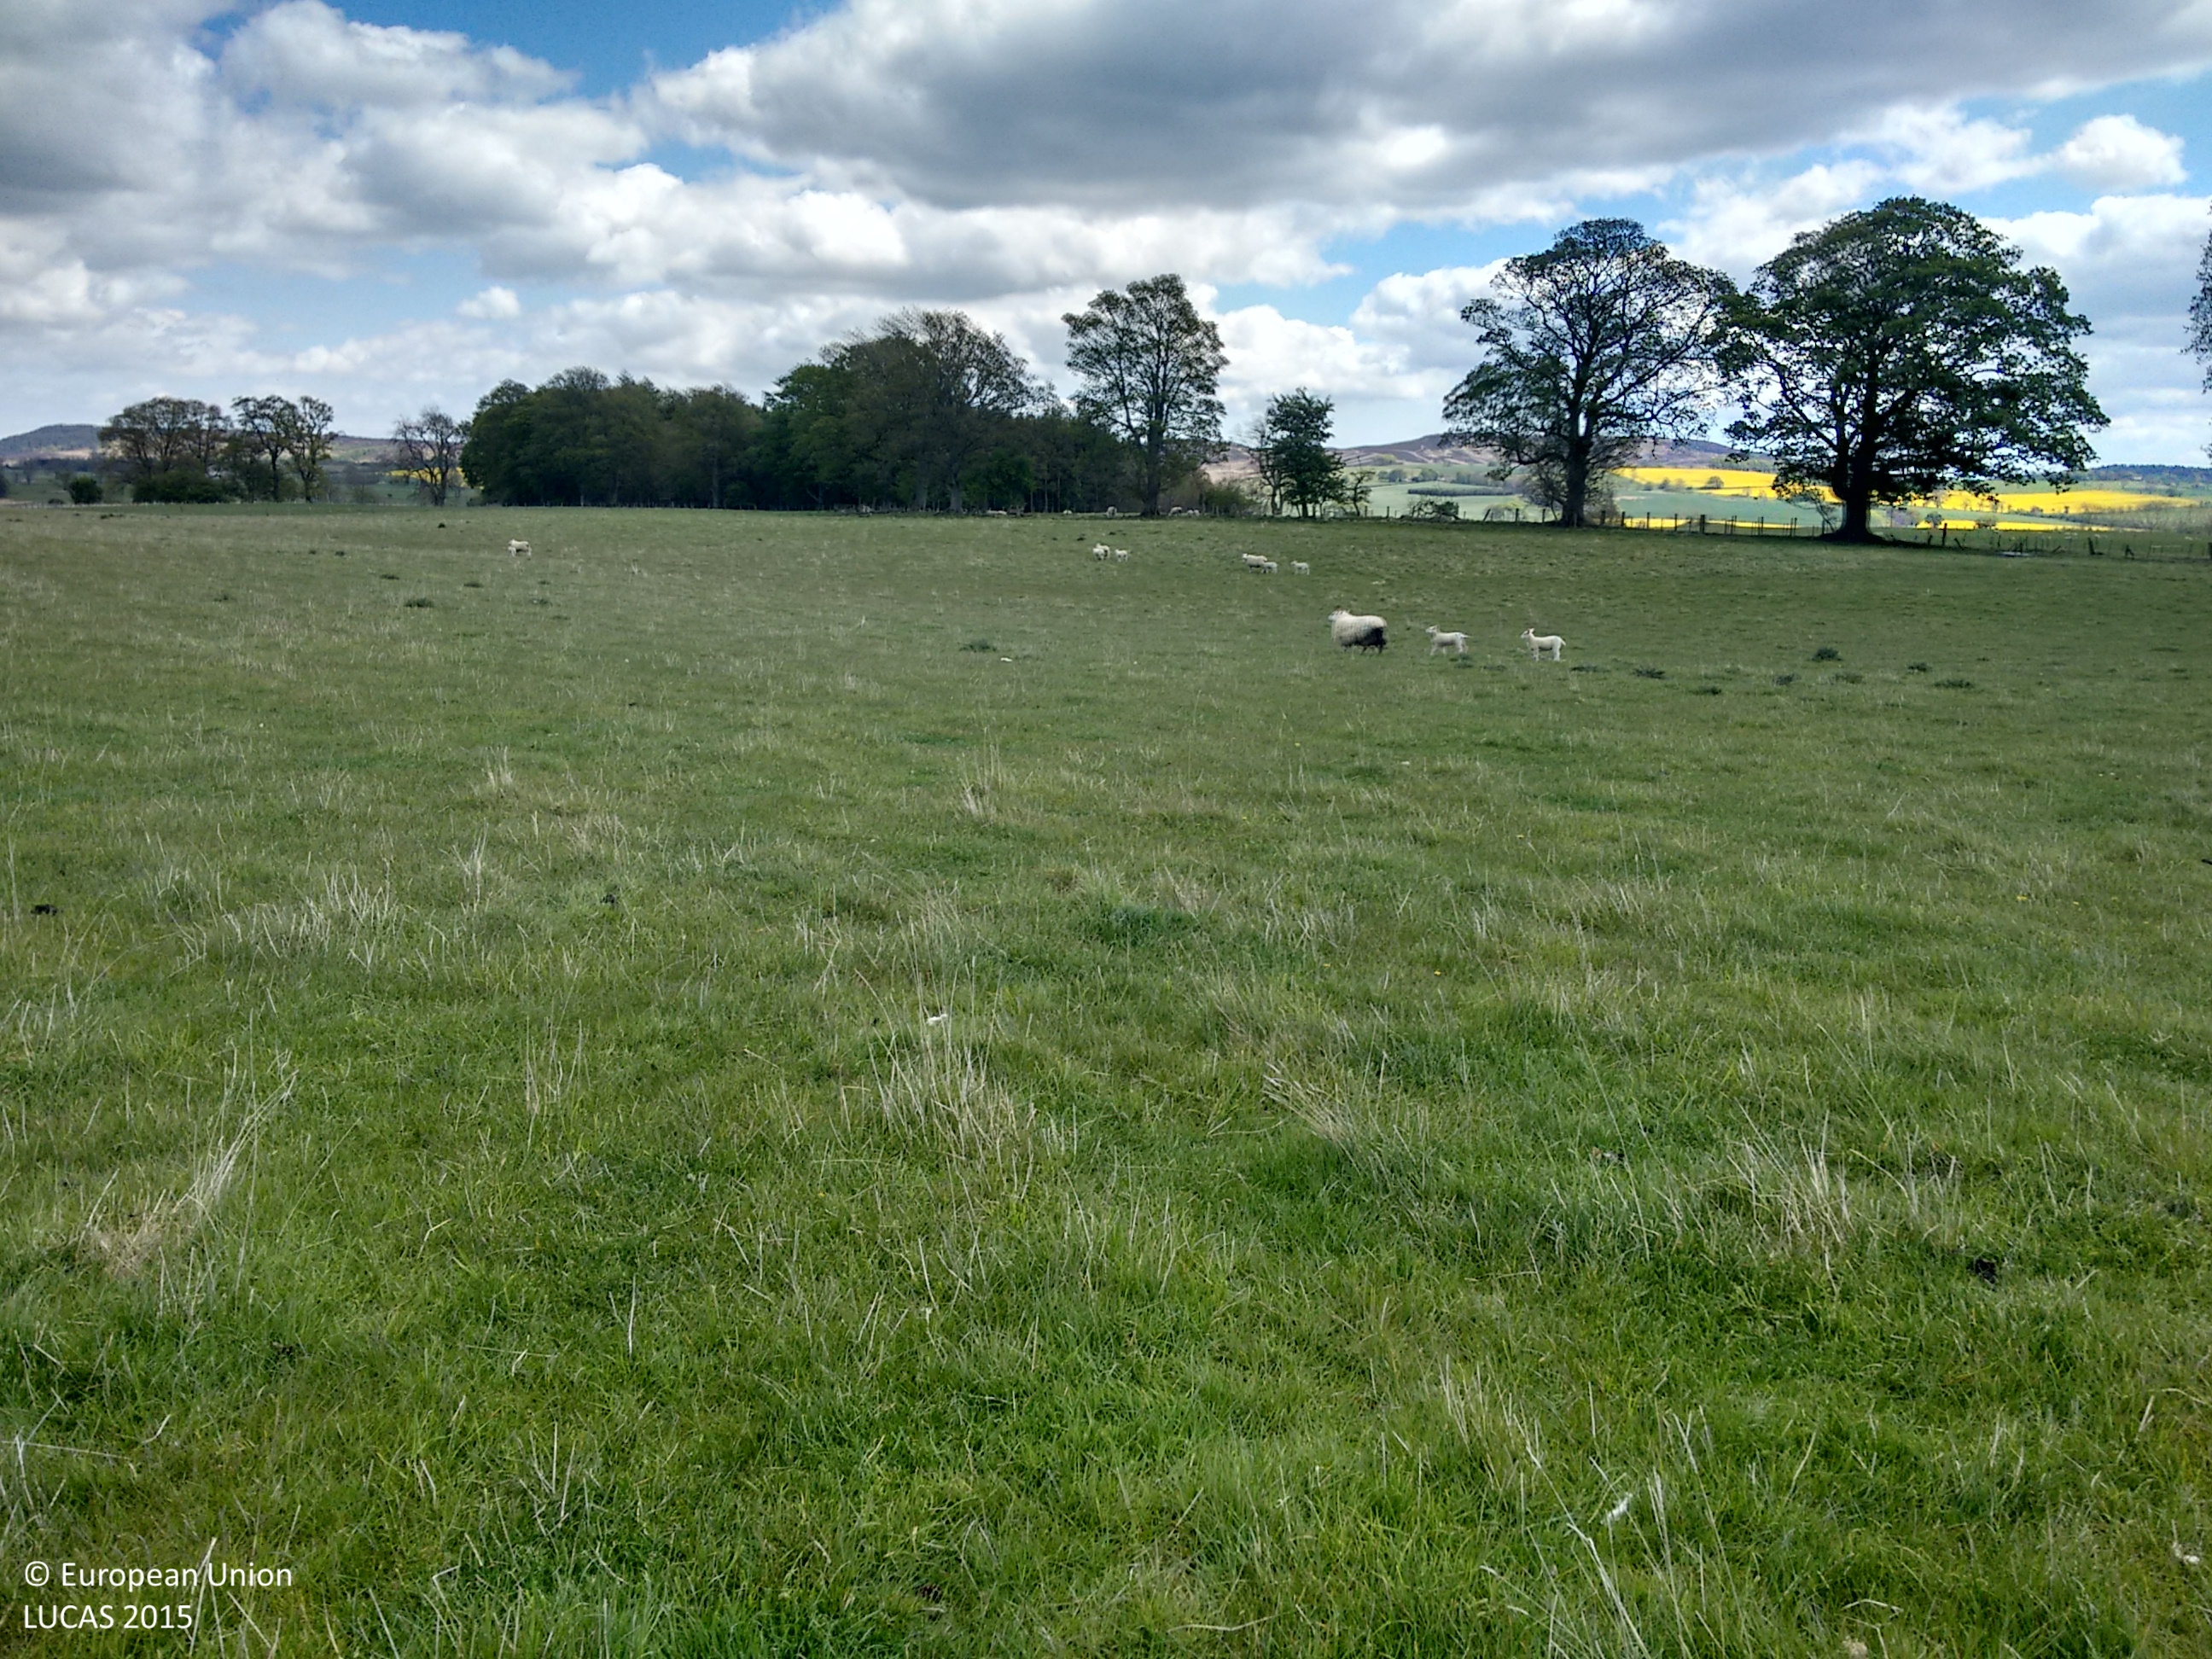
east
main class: Grassland
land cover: Grassland without tree/shrub cover
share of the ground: > 75 %
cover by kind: herbaceous plants 100 %
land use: Agriculture (excluding fallow land and kitchen gardens)
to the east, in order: Grassland without tree/shrub cover; Fences; Abandoned hedges; Grassland without tree/shrub cover; Fences; Pine dominated coniferous woodland
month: May
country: GB
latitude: 55.3500
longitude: -1.9919
